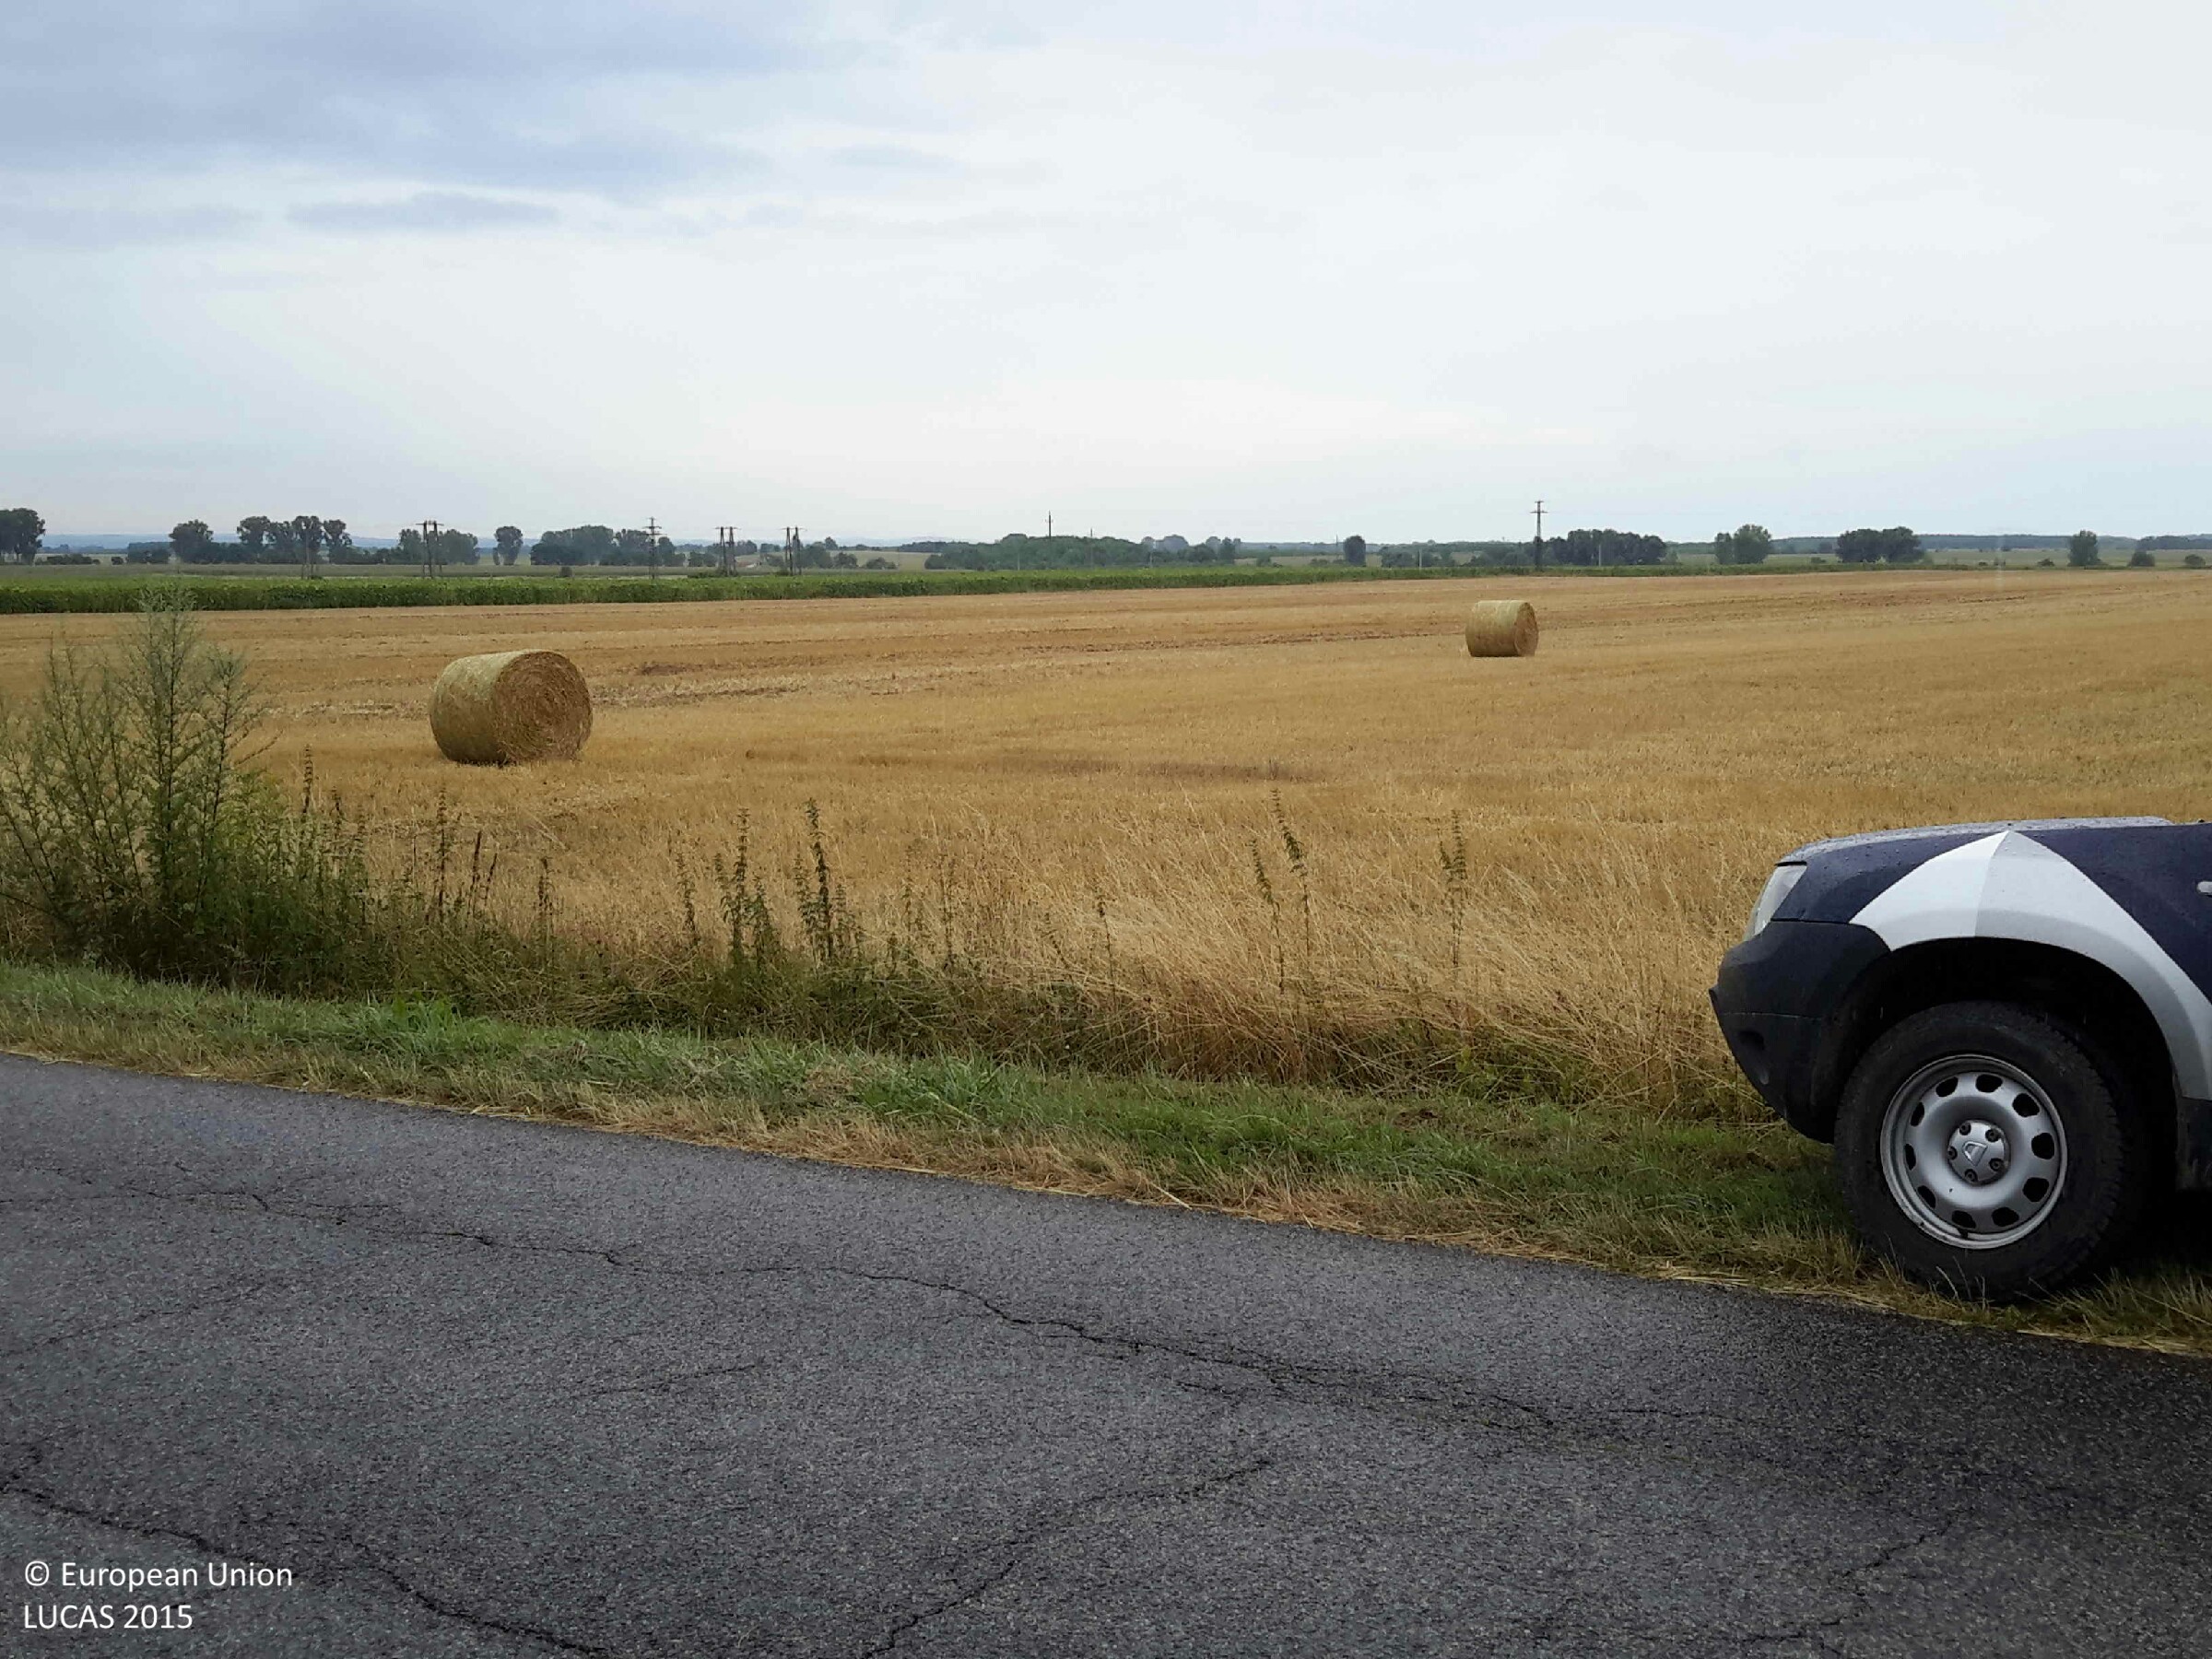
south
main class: Shrubland
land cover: Shrubland without tree cover
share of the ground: > 75 %
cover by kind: shrubs 100 %
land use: Forestry
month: July
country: HU
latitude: 47.4634
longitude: 17.4766
